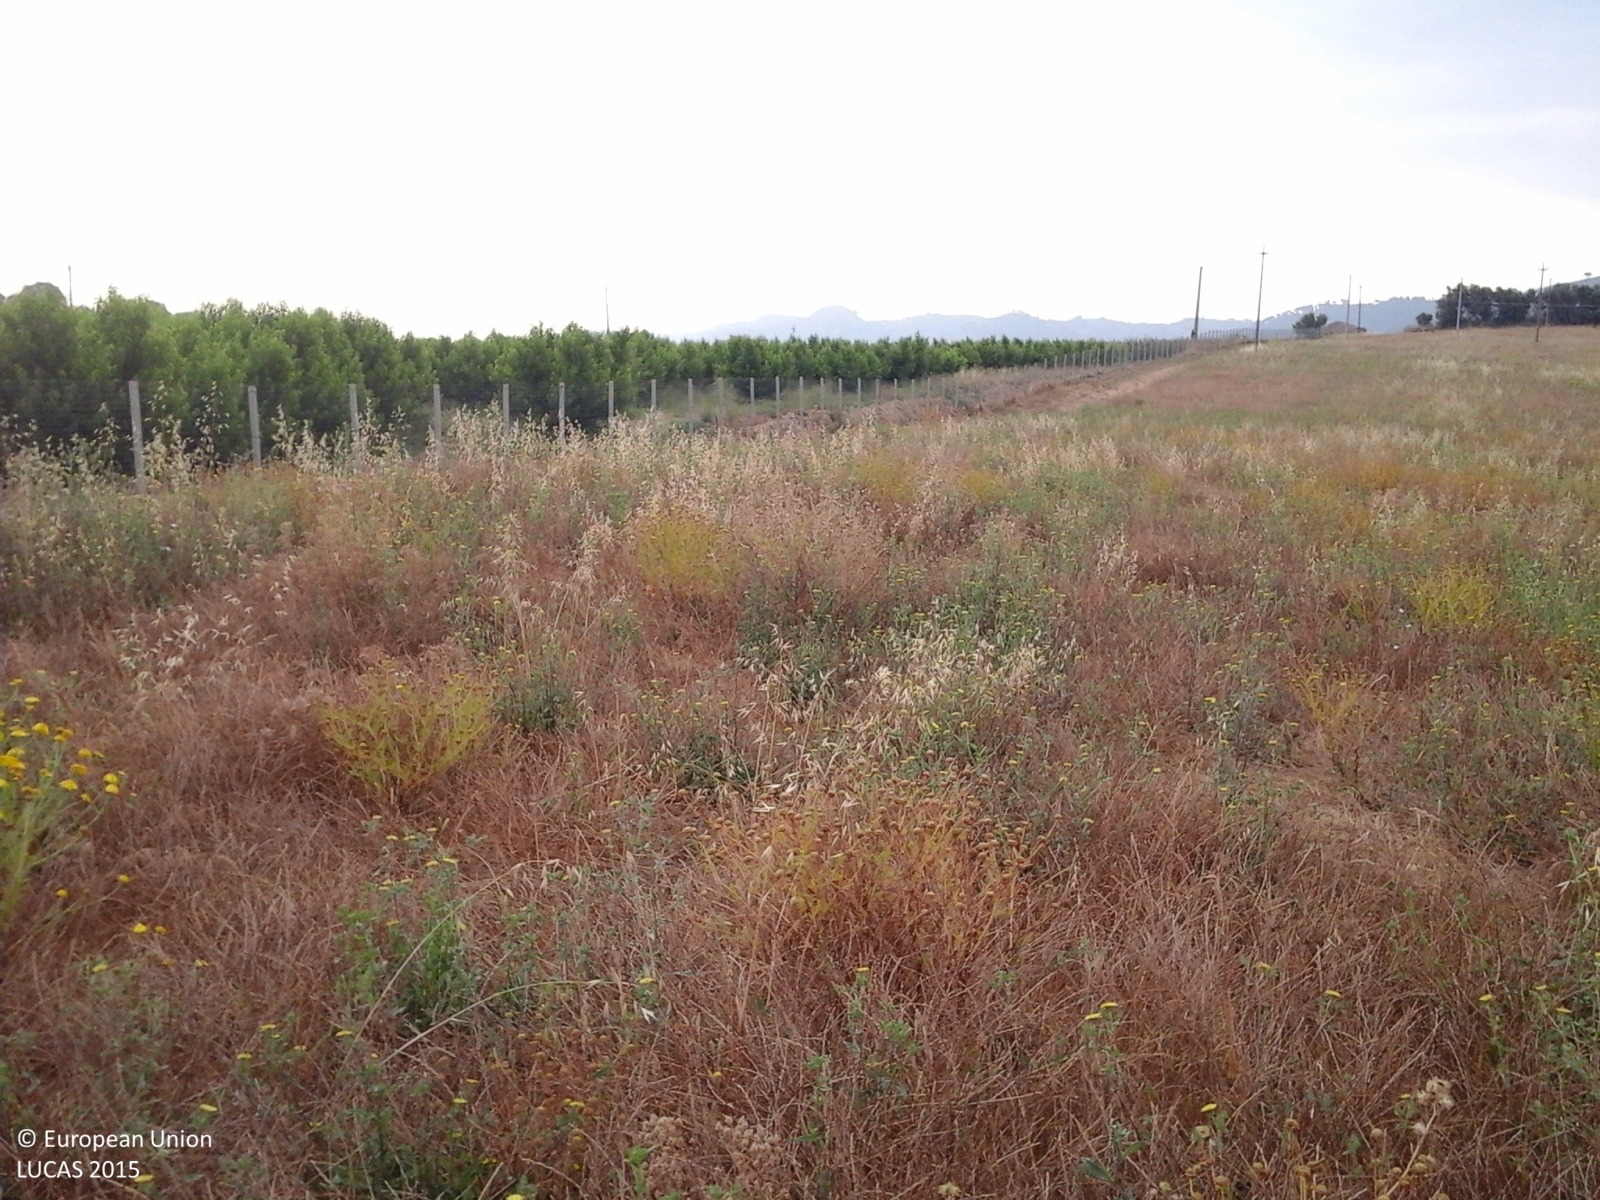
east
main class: Grassland
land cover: Spontaneously vegetated surfaces
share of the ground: > 75 %
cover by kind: herbaceous plants 100 %
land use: Fallow land
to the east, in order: Spontaneously vegetated surfaces; Grass margins; Fences; Grass margins; Other fruit trees and berries; Grass margins; Tracks; Grass margins; Other fruit trees and berries
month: June
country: IT
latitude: 37.2374
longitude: 14.5754
